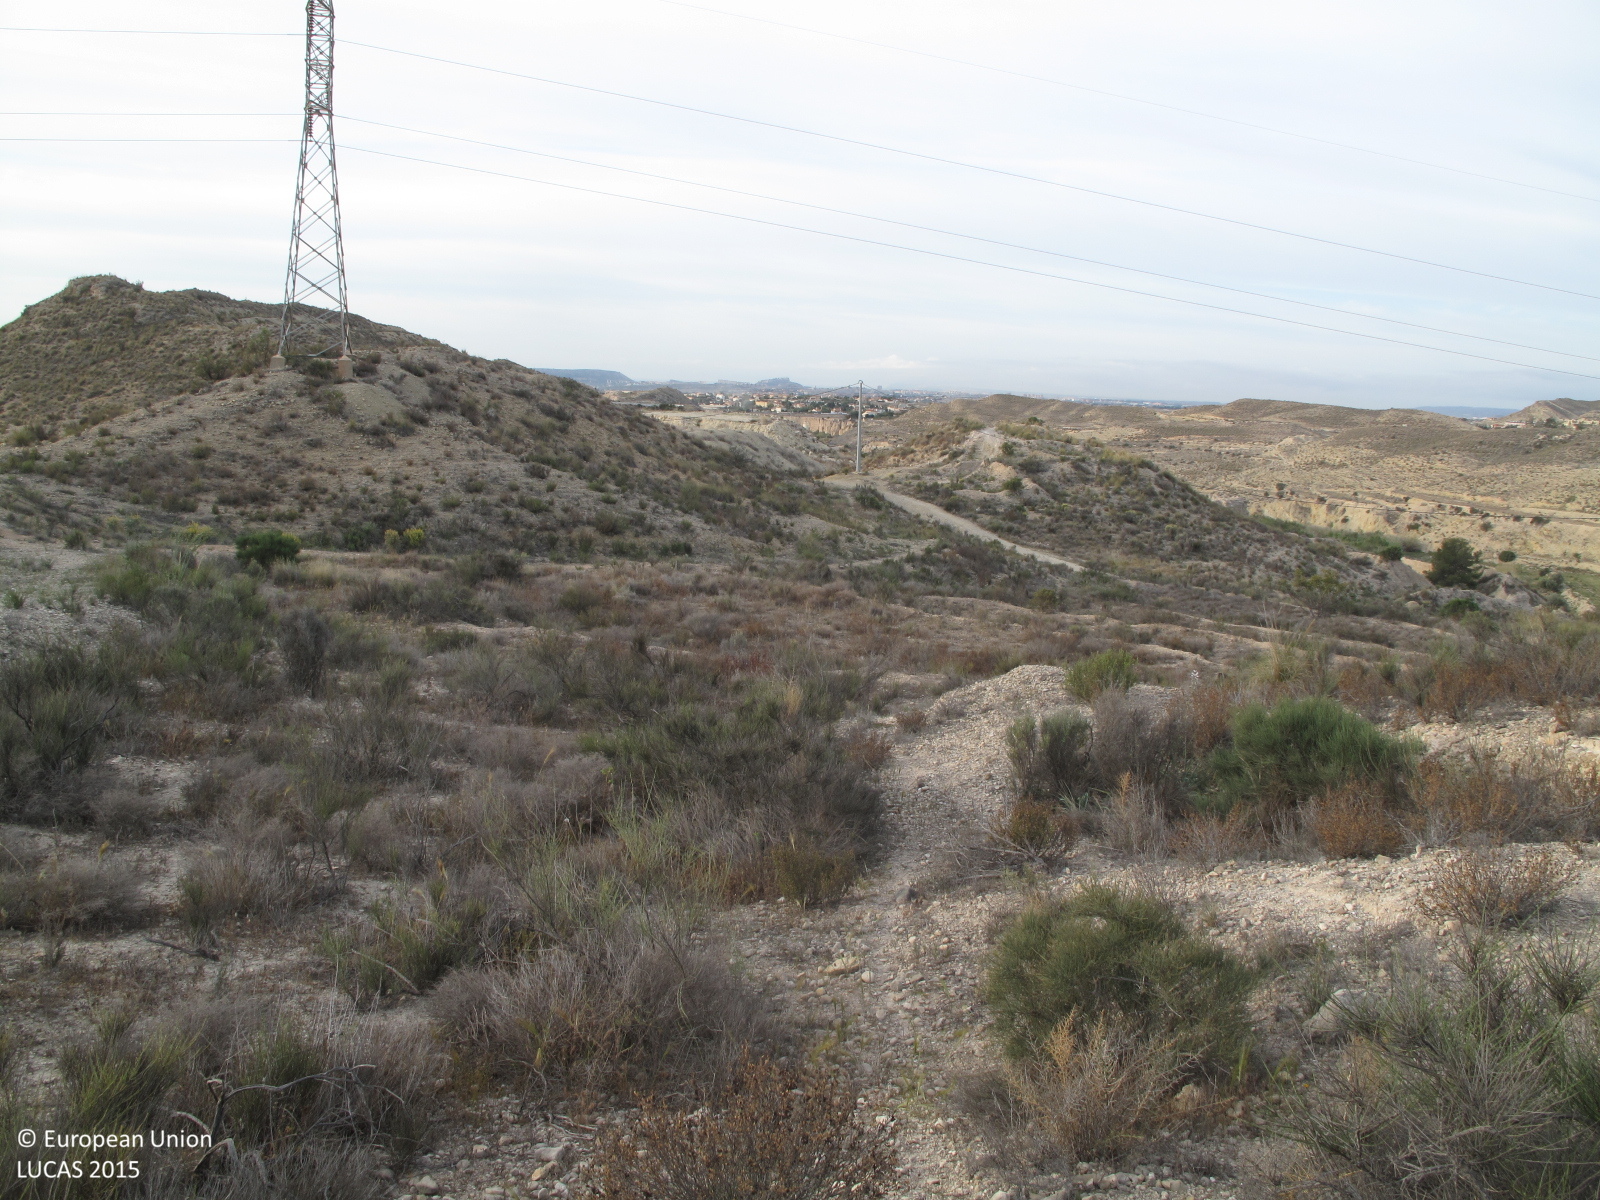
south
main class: Shrubland
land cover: Shrubland without tree cover
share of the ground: 25 - 50 %
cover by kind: consolidated bare surface 50 %, shrubs 30 %, herbaceous plants 20 %
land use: Semi-natural and natural areas not in use
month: April
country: ES
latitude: 38.4646
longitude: -0.4733
